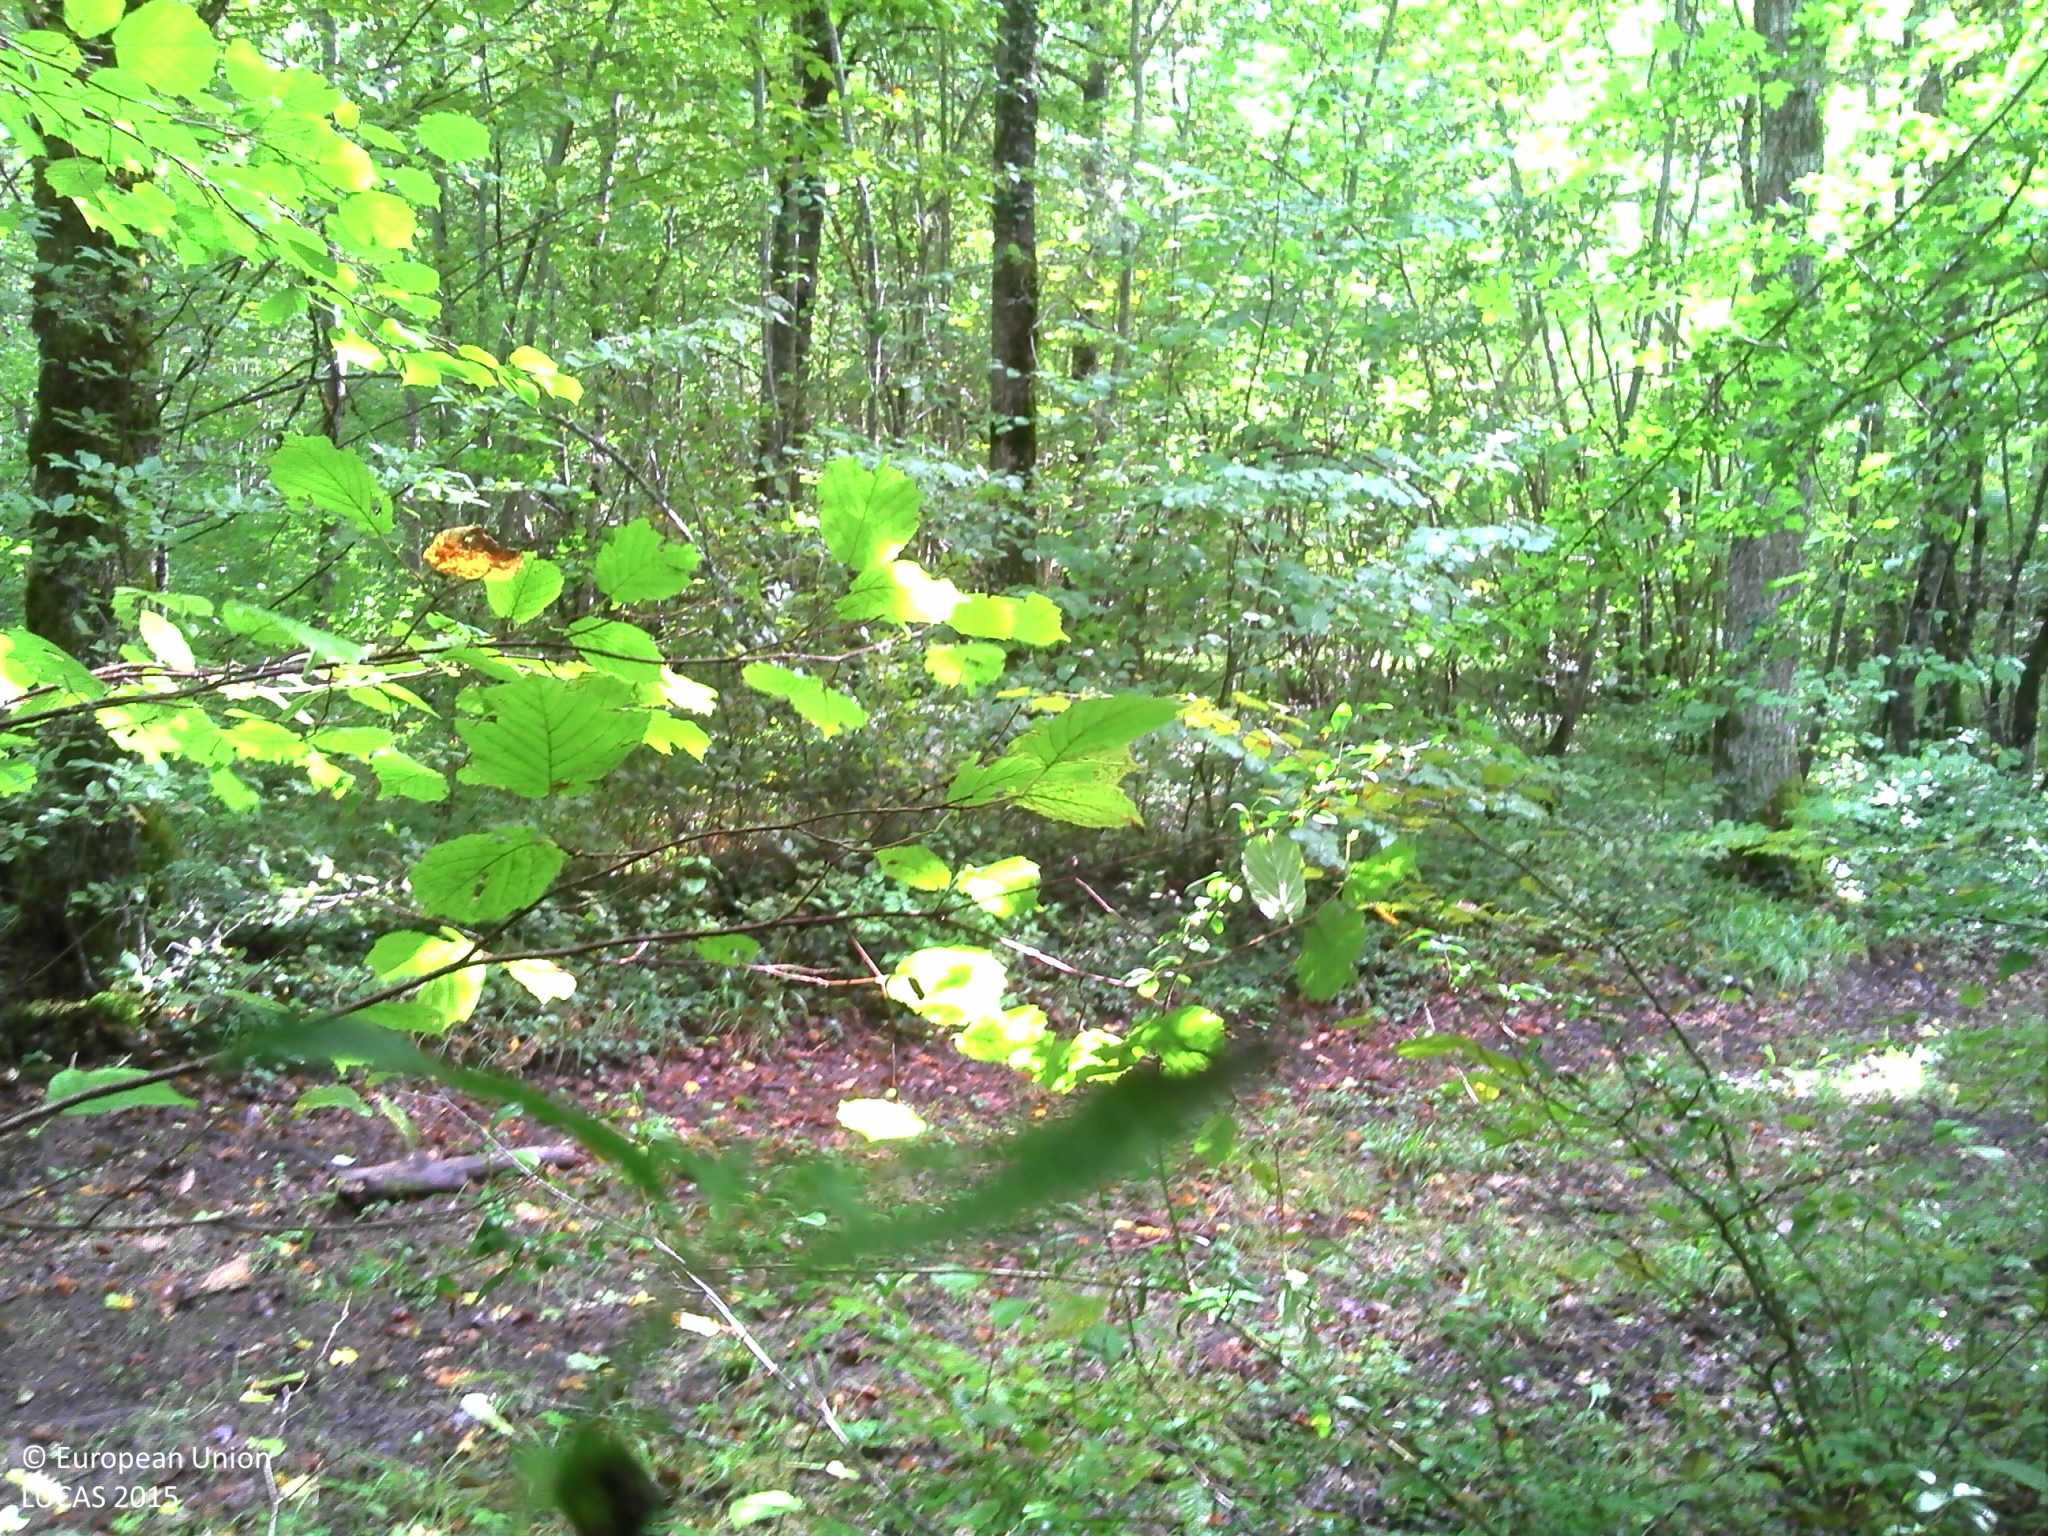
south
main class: Woodland
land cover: Broadleaved woodland
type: mesophytic deciduous forest
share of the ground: > 75 %
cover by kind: broadleaved forest trees 90 %, herbaceous plants 5 %, lichens and mosses 5 %
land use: Forestry
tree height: > 5 m
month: September
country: FR
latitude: 47.6784
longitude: 4.2838
